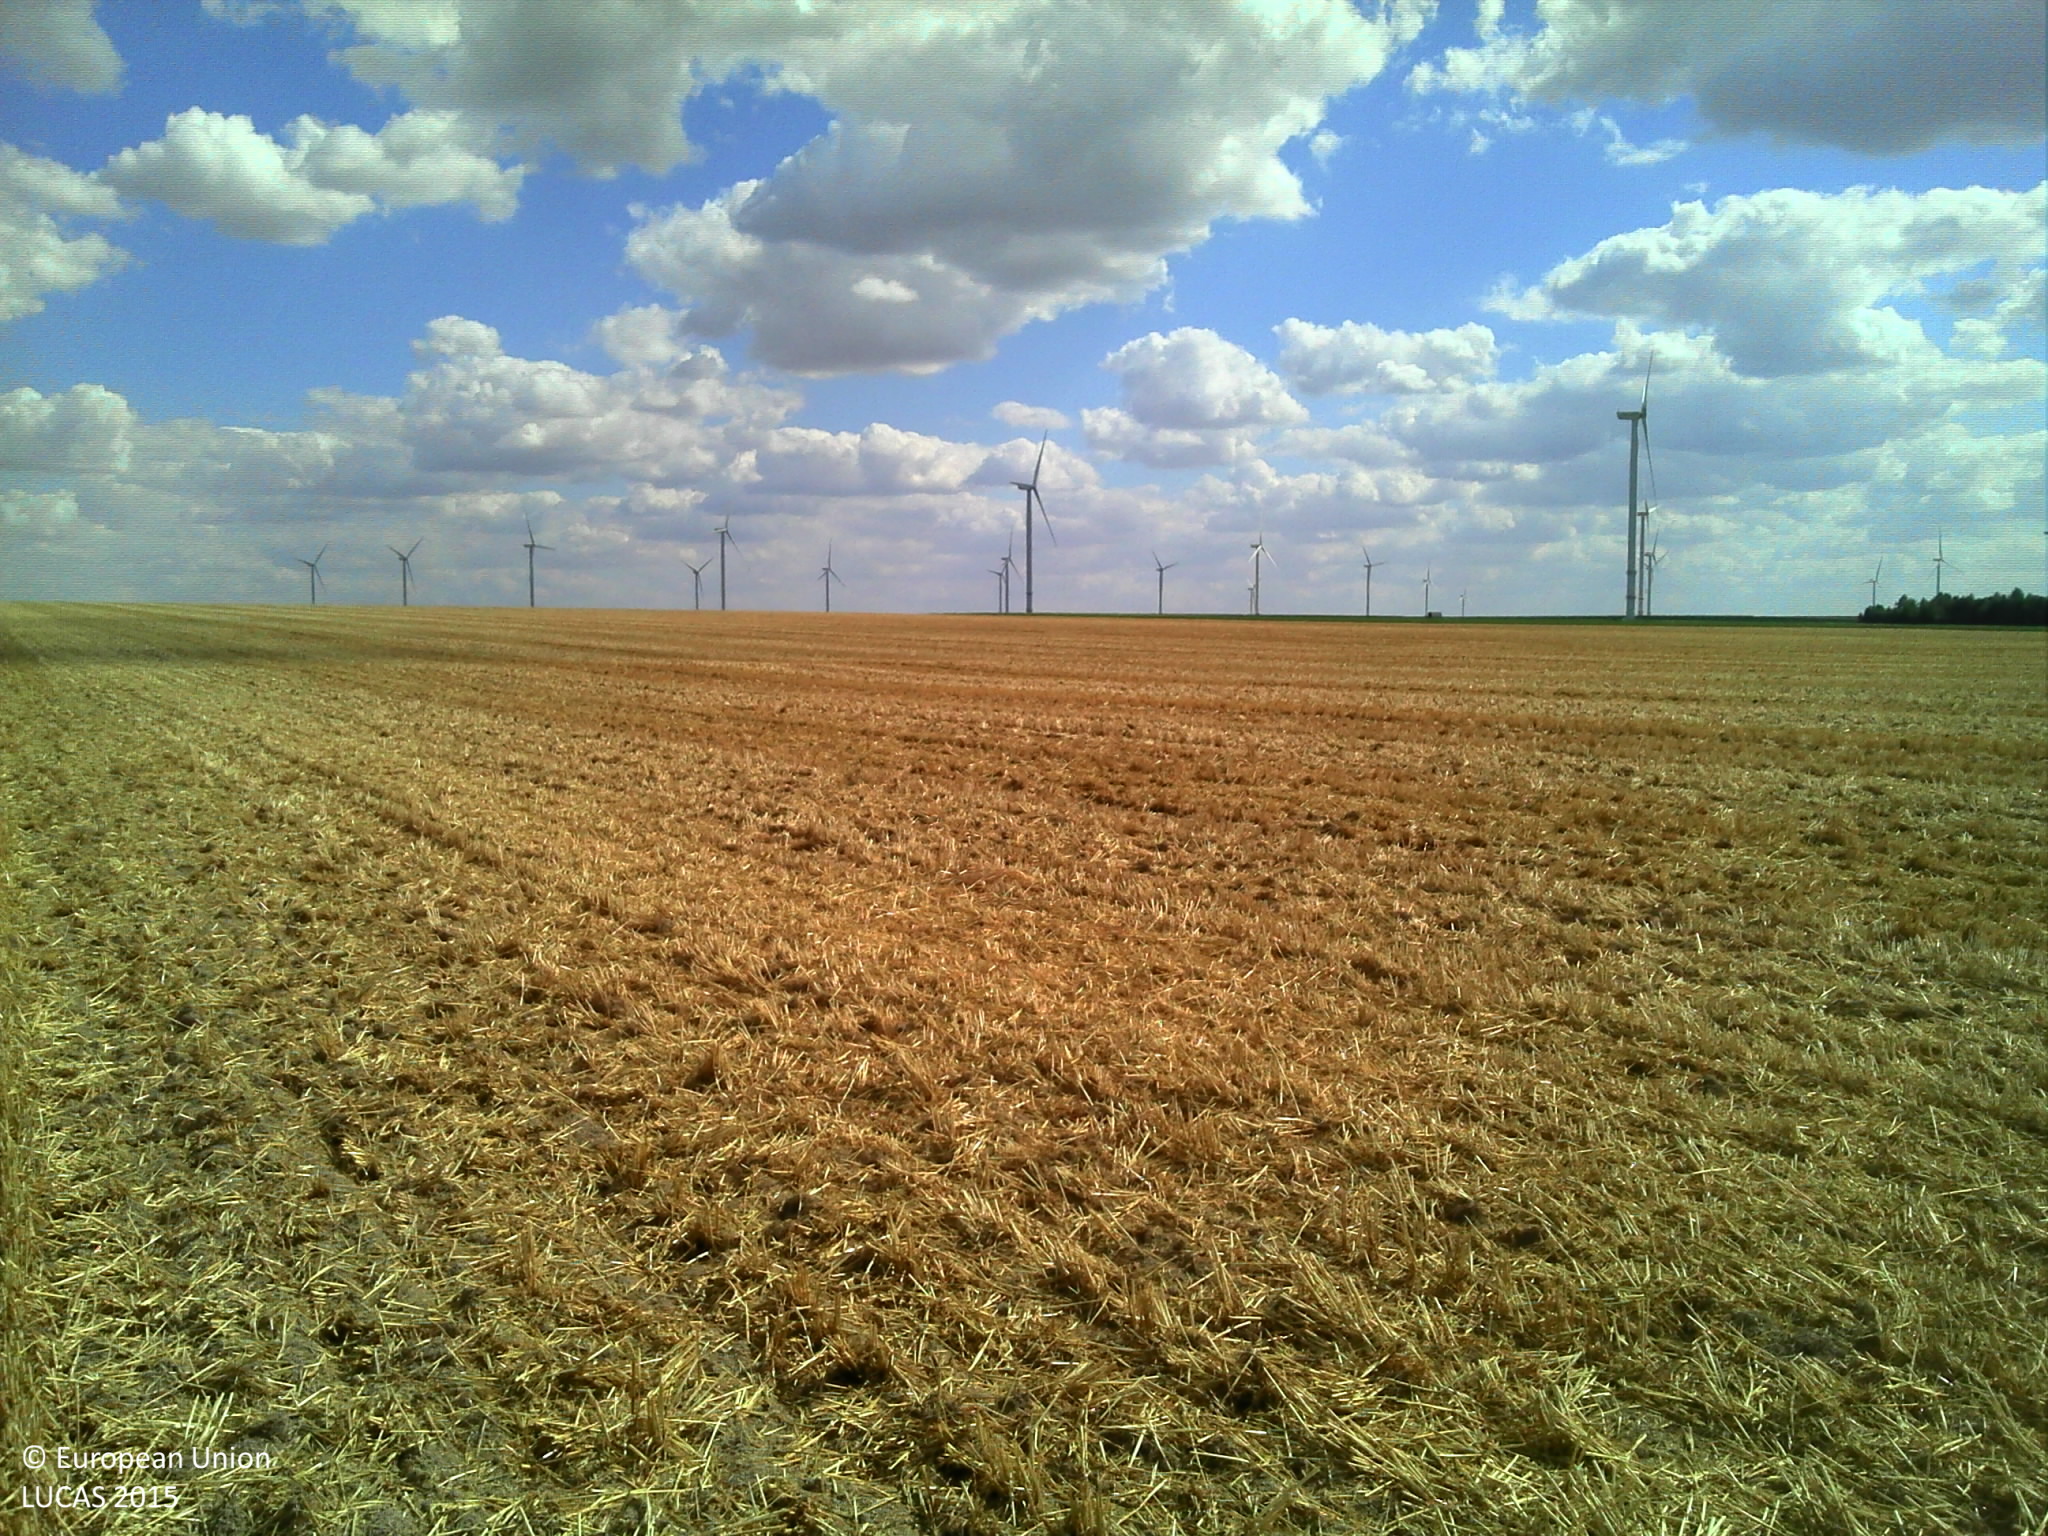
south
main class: Cropland
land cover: Common wheat
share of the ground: > 75 %
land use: Agriculture (excluding fallow land and kitchen gardens)
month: July
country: FR
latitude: 48.9184
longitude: 4.1961
